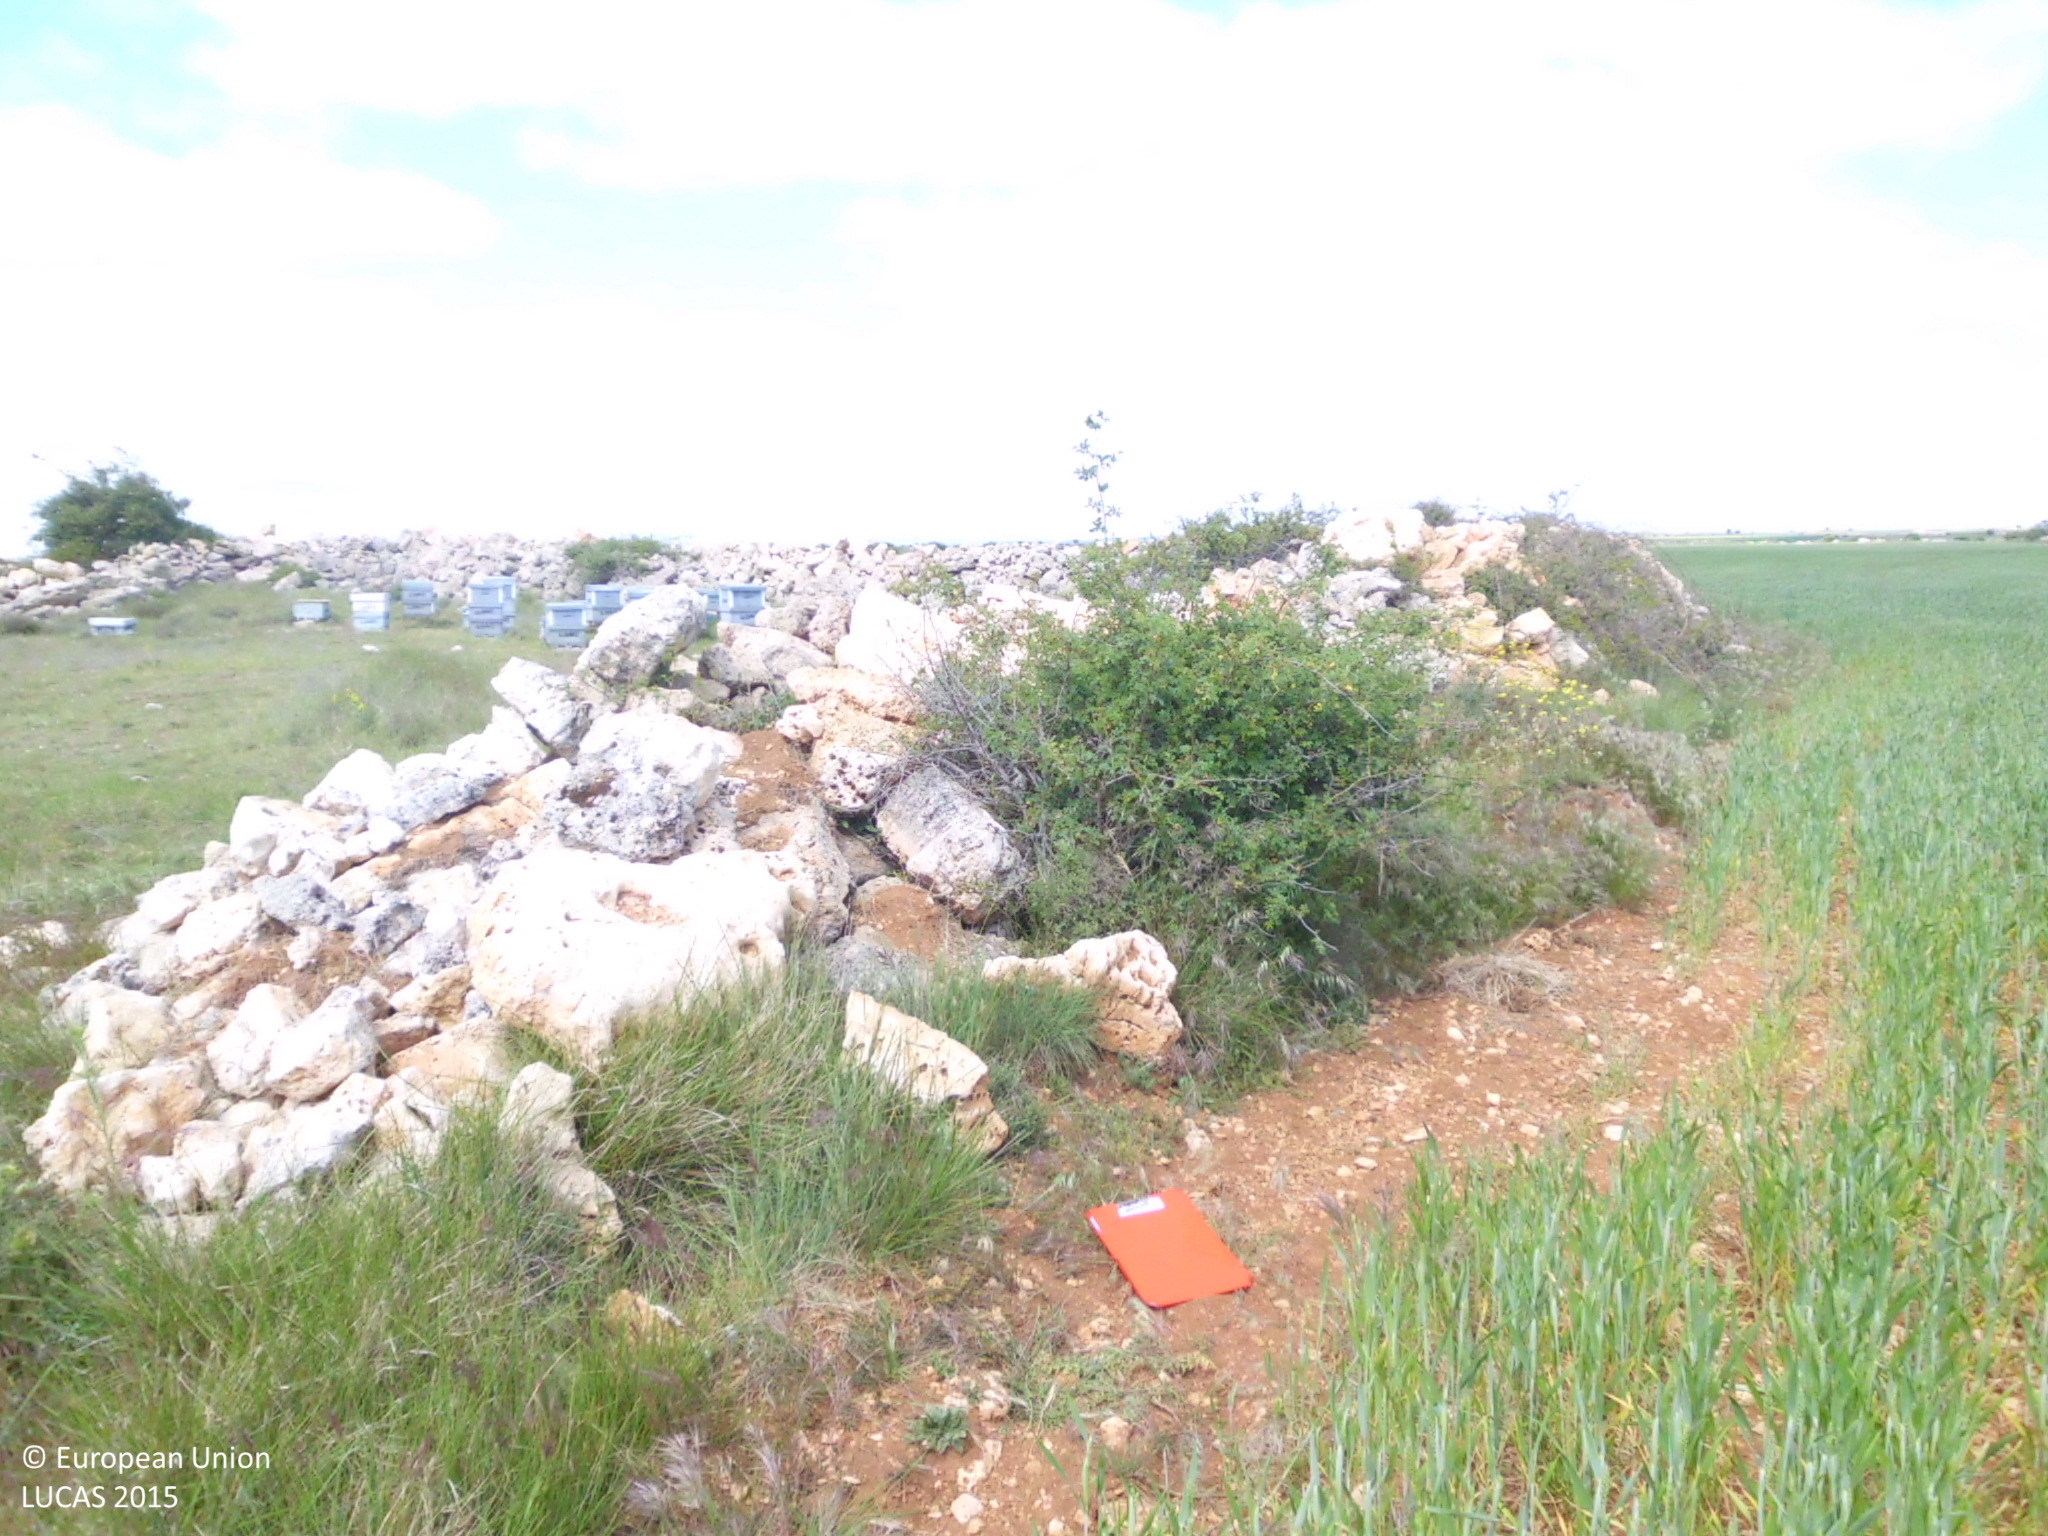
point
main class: Cropland
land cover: Common wheat
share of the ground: > 75 %
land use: Agriculture (excluding fallow land and kitchen gardens)
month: May
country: ES
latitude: 42.4112
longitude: -3.9789
